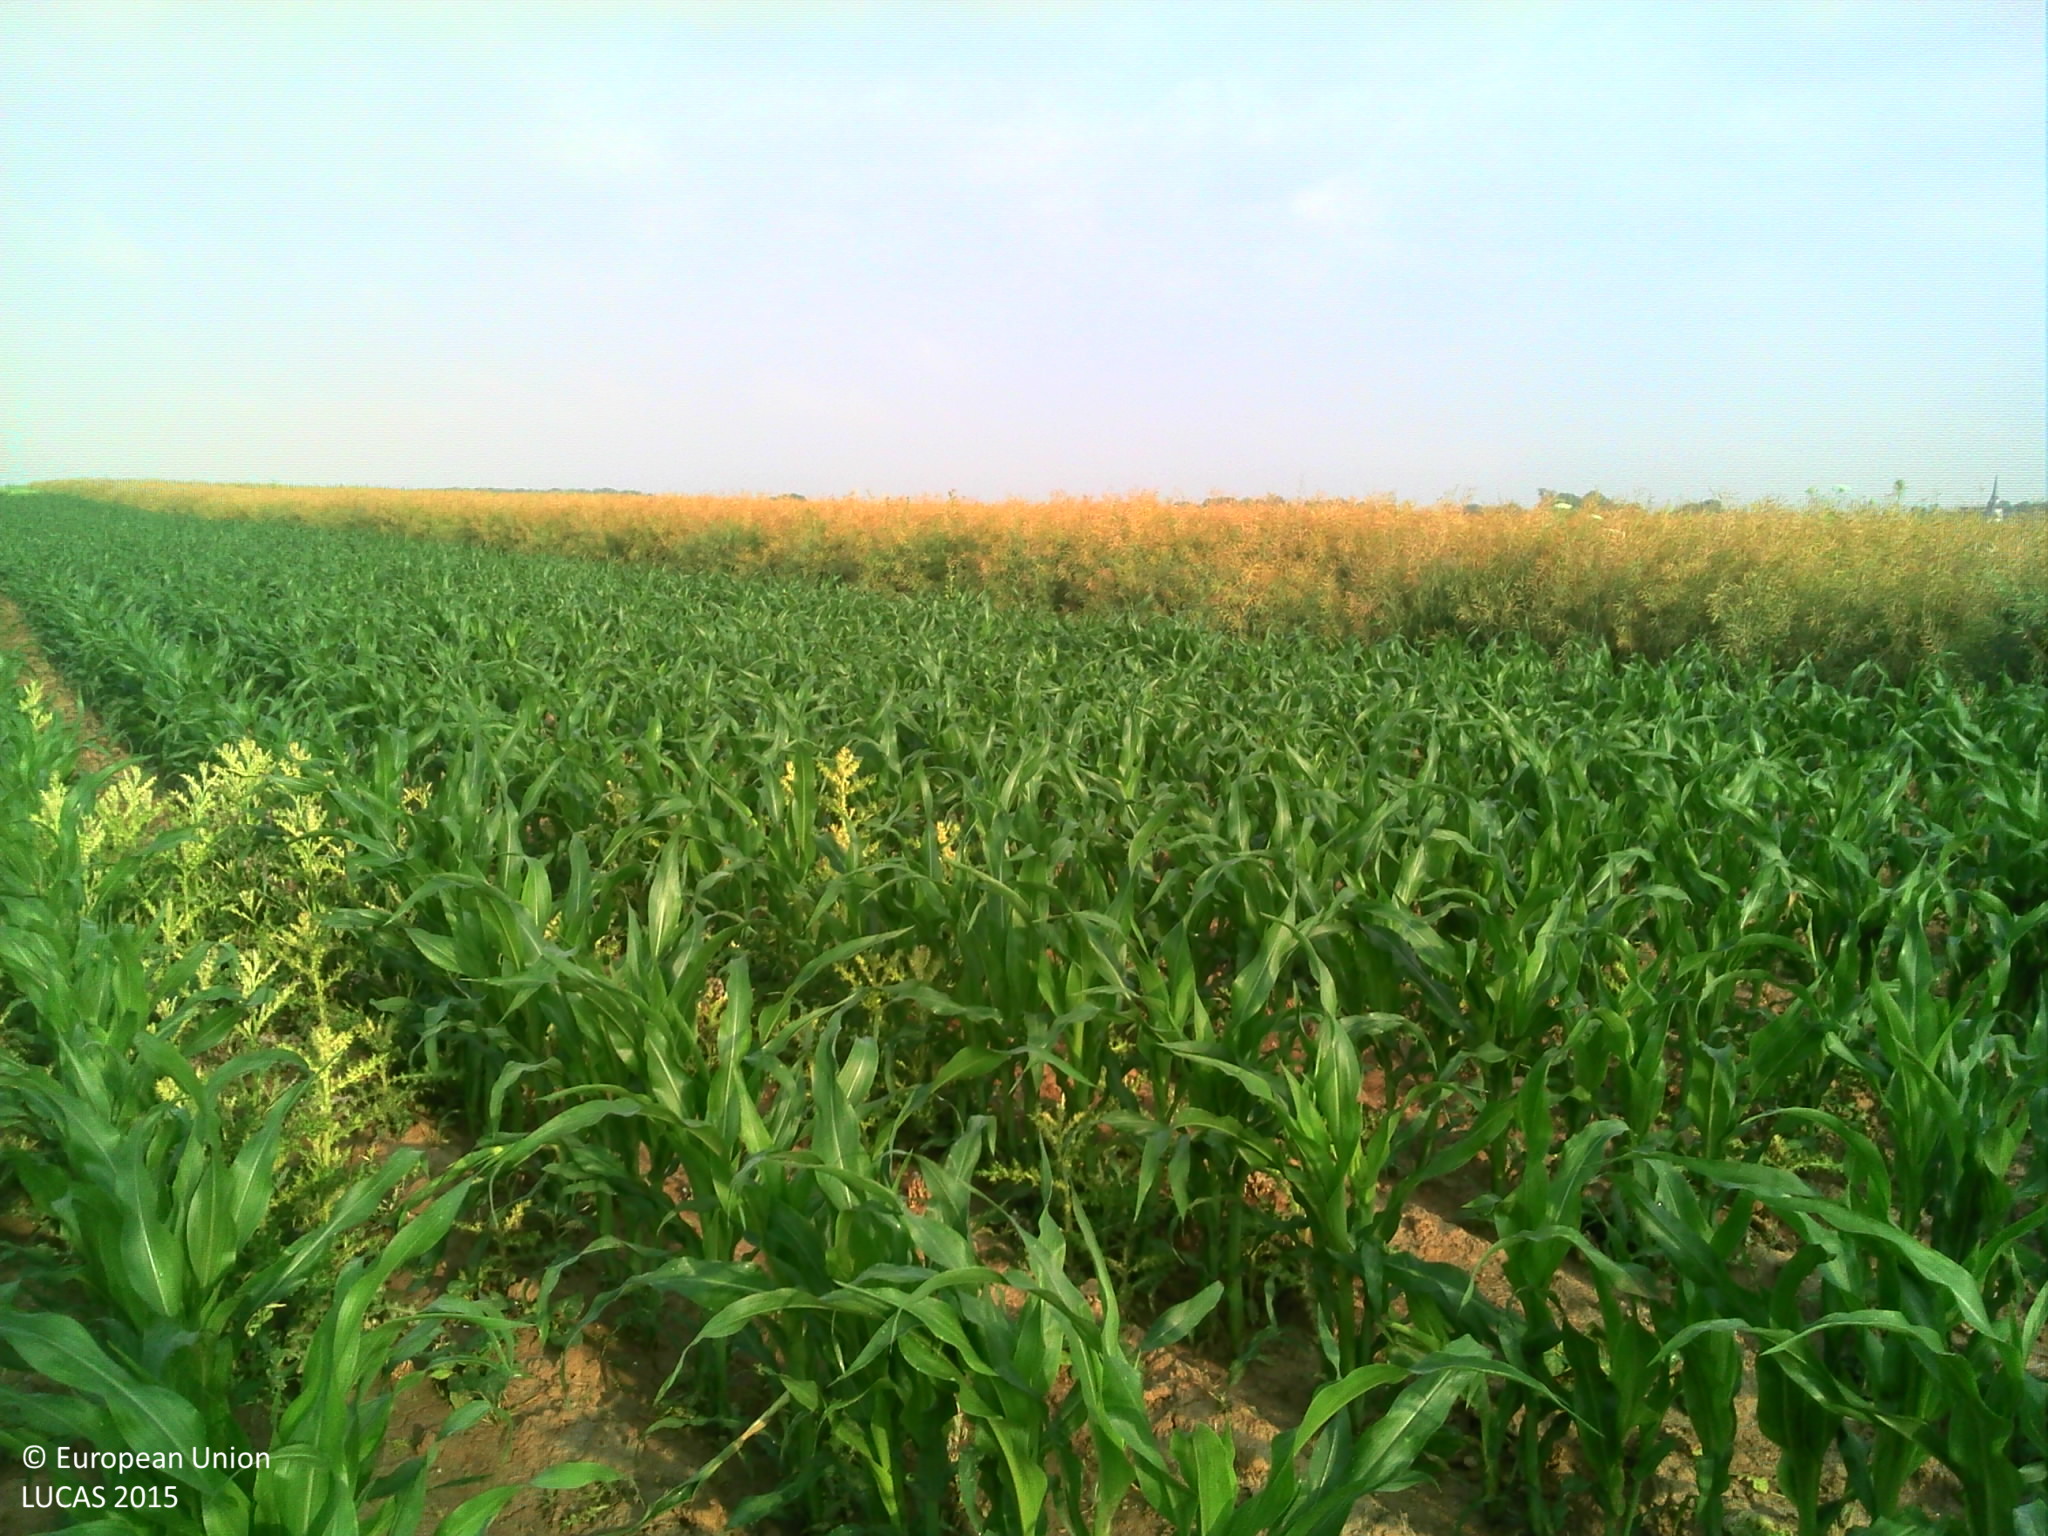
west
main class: Cropland
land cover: Maize
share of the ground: 25 - 50 %
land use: Agriculture (excluding fallow land and kitchen gardens)
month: July
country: FR
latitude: 49.7426
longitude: 2.5640
